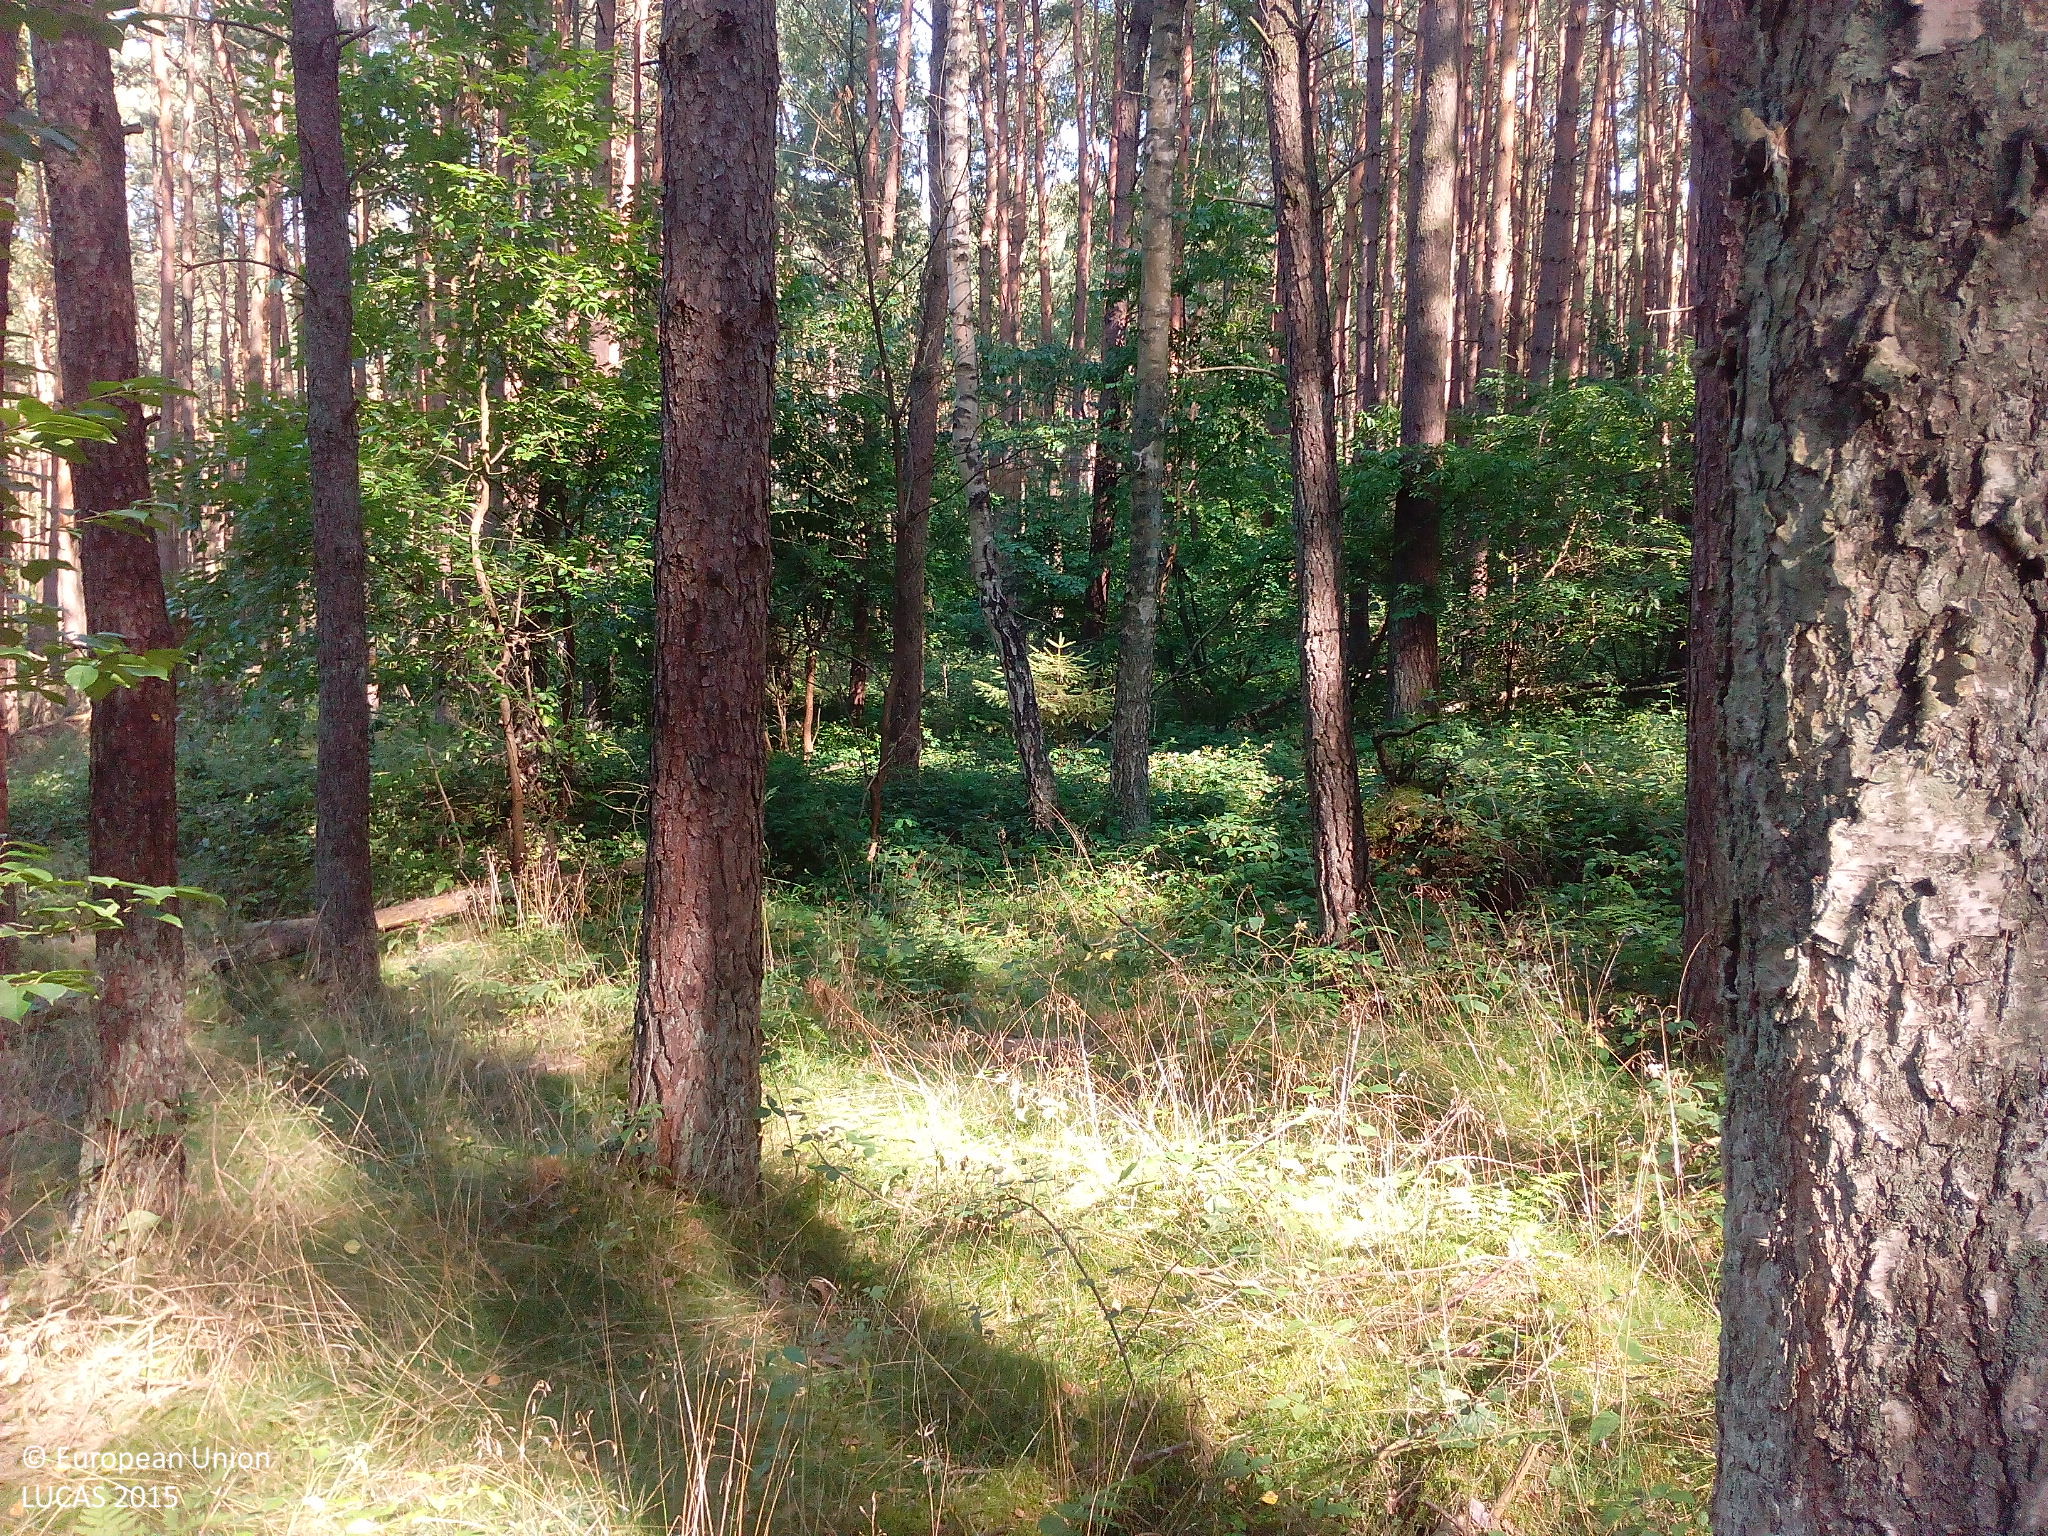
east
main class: Woodland
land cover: Pine dominated mixed woodland
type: hemiboreal forest and nemoral coniferous forest and mixed broadleaved-coniferous forest
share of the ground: > 75 %
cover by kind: coniferous forest trees 60 %, broadleaved forest trees 25 %, herbaceous plants 10 %, shrubs 5 %
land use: Forestry
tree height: > 5 m
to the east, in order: Pine dominated mixed woodland; Pine dominated coniferous woodland; Tracks; Pine dominated mixed woodland
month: August
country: DE
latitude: 53.5945
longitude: 12.3714
